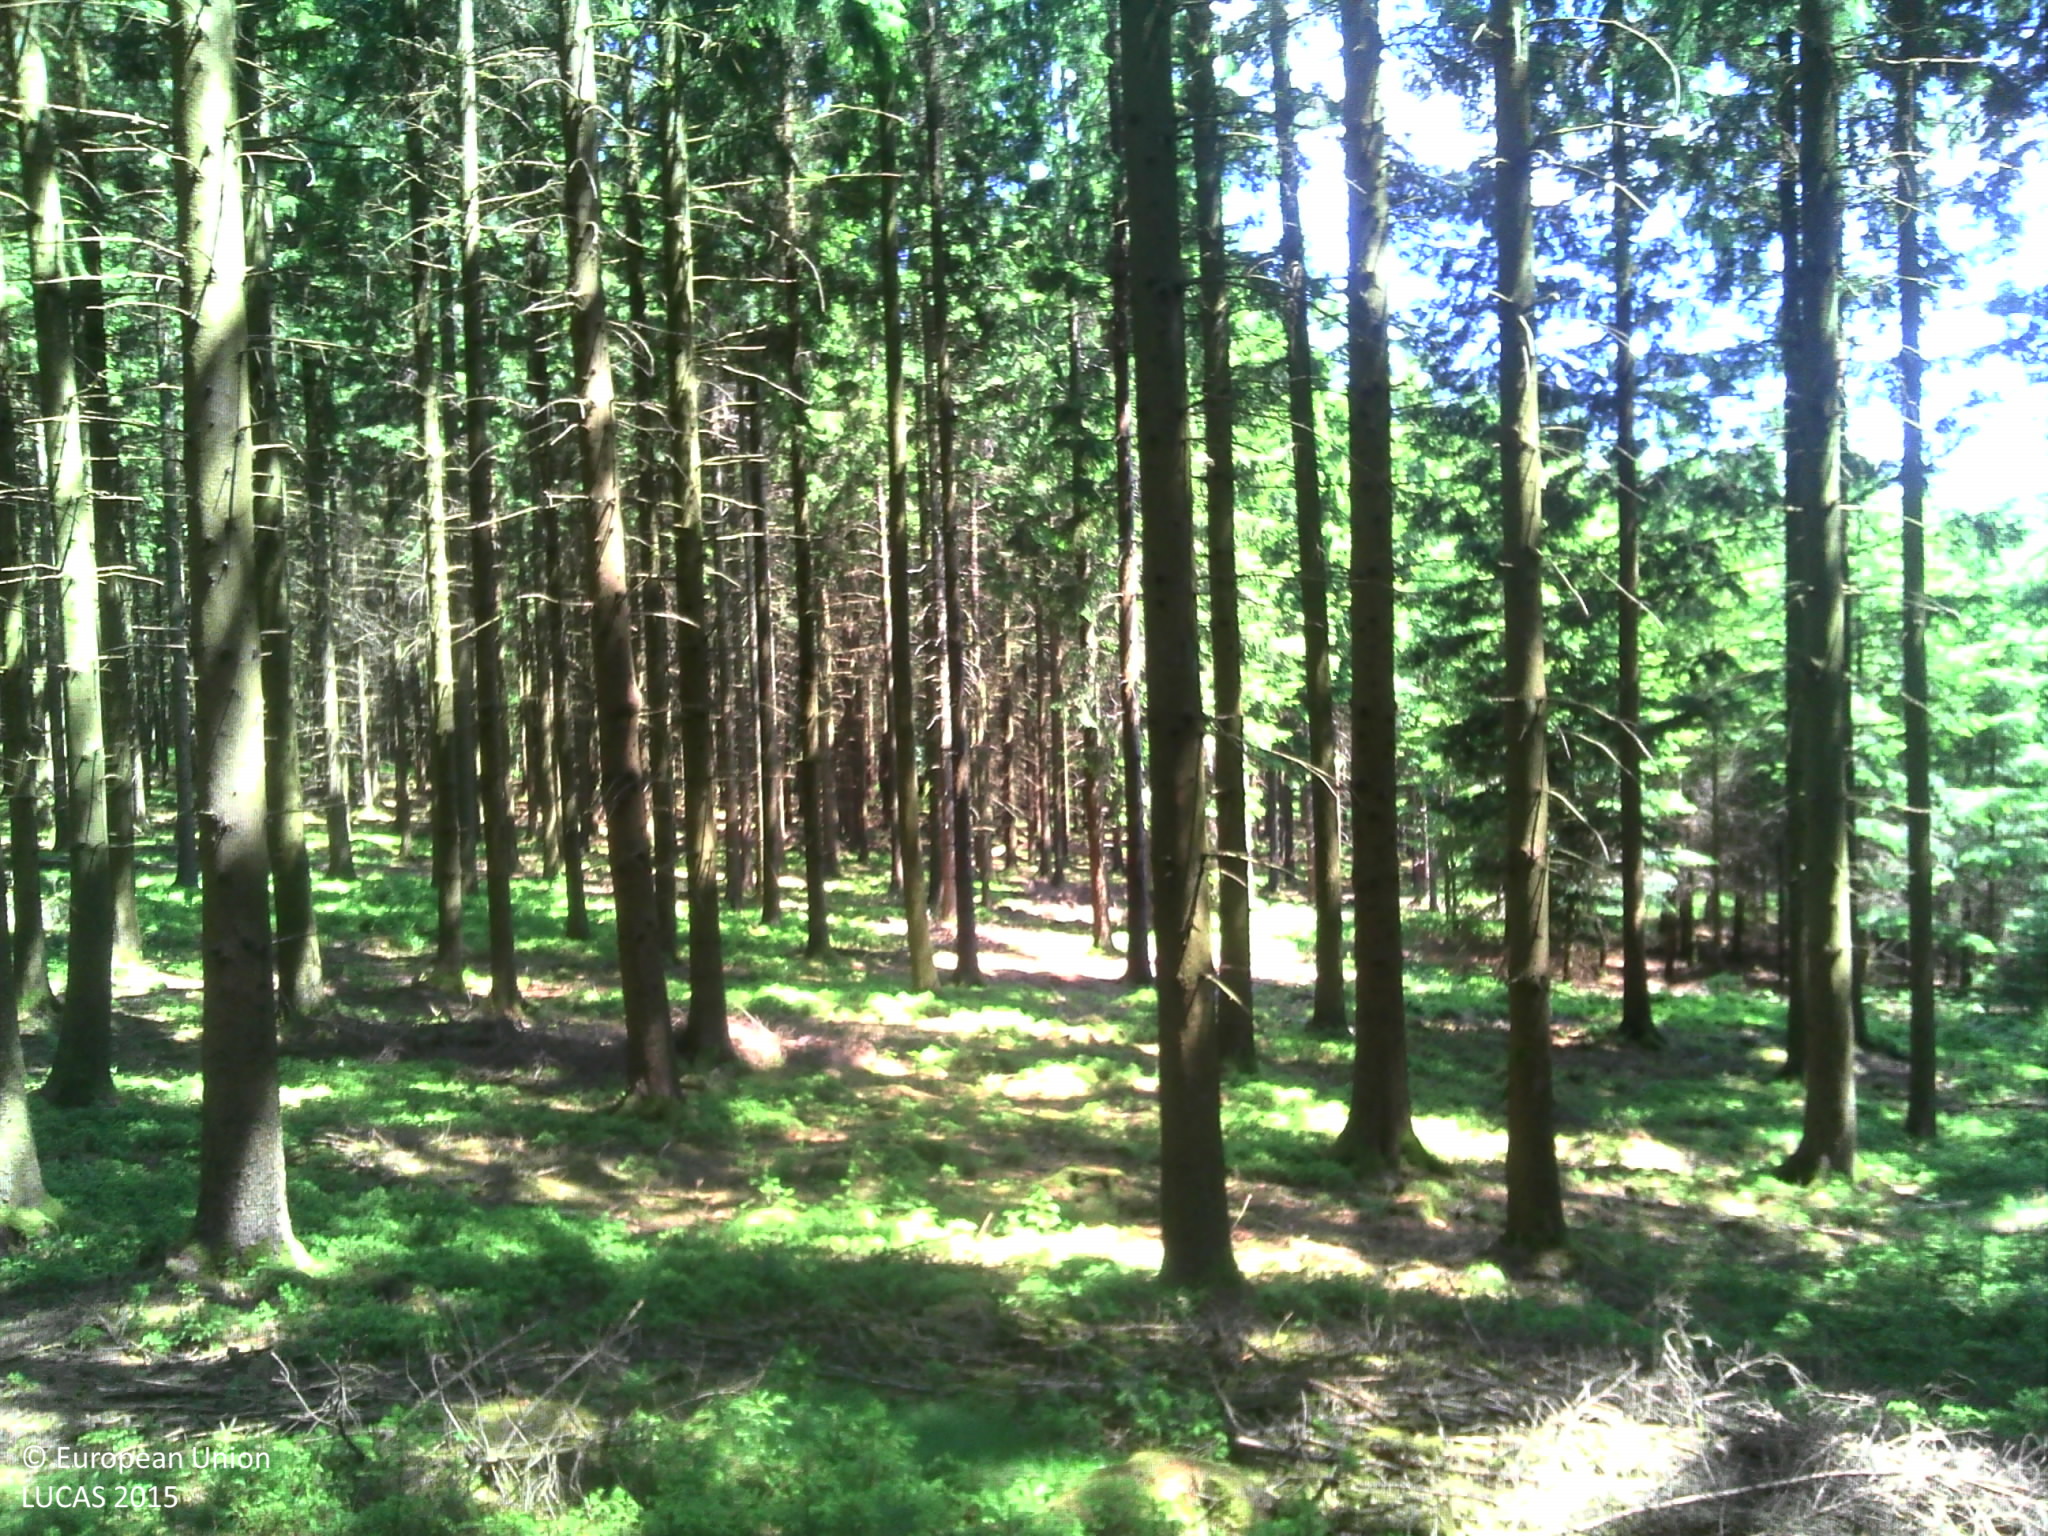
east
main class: Woodland
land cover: Spruce dominated coniferous woodland
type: alpine coniferous forest
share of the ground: > 75 %
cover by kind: coniferous forest trees 95 %, unconsolidated bare surface 5 %
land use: Forestry
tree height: > 5 m
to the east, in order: Spruce dominated coniferous woodland; Tracks; Broadleaved woodland; Spruce dominated coniferous woodland
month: June
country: BE
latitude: 49.9815
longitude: 4.5433
